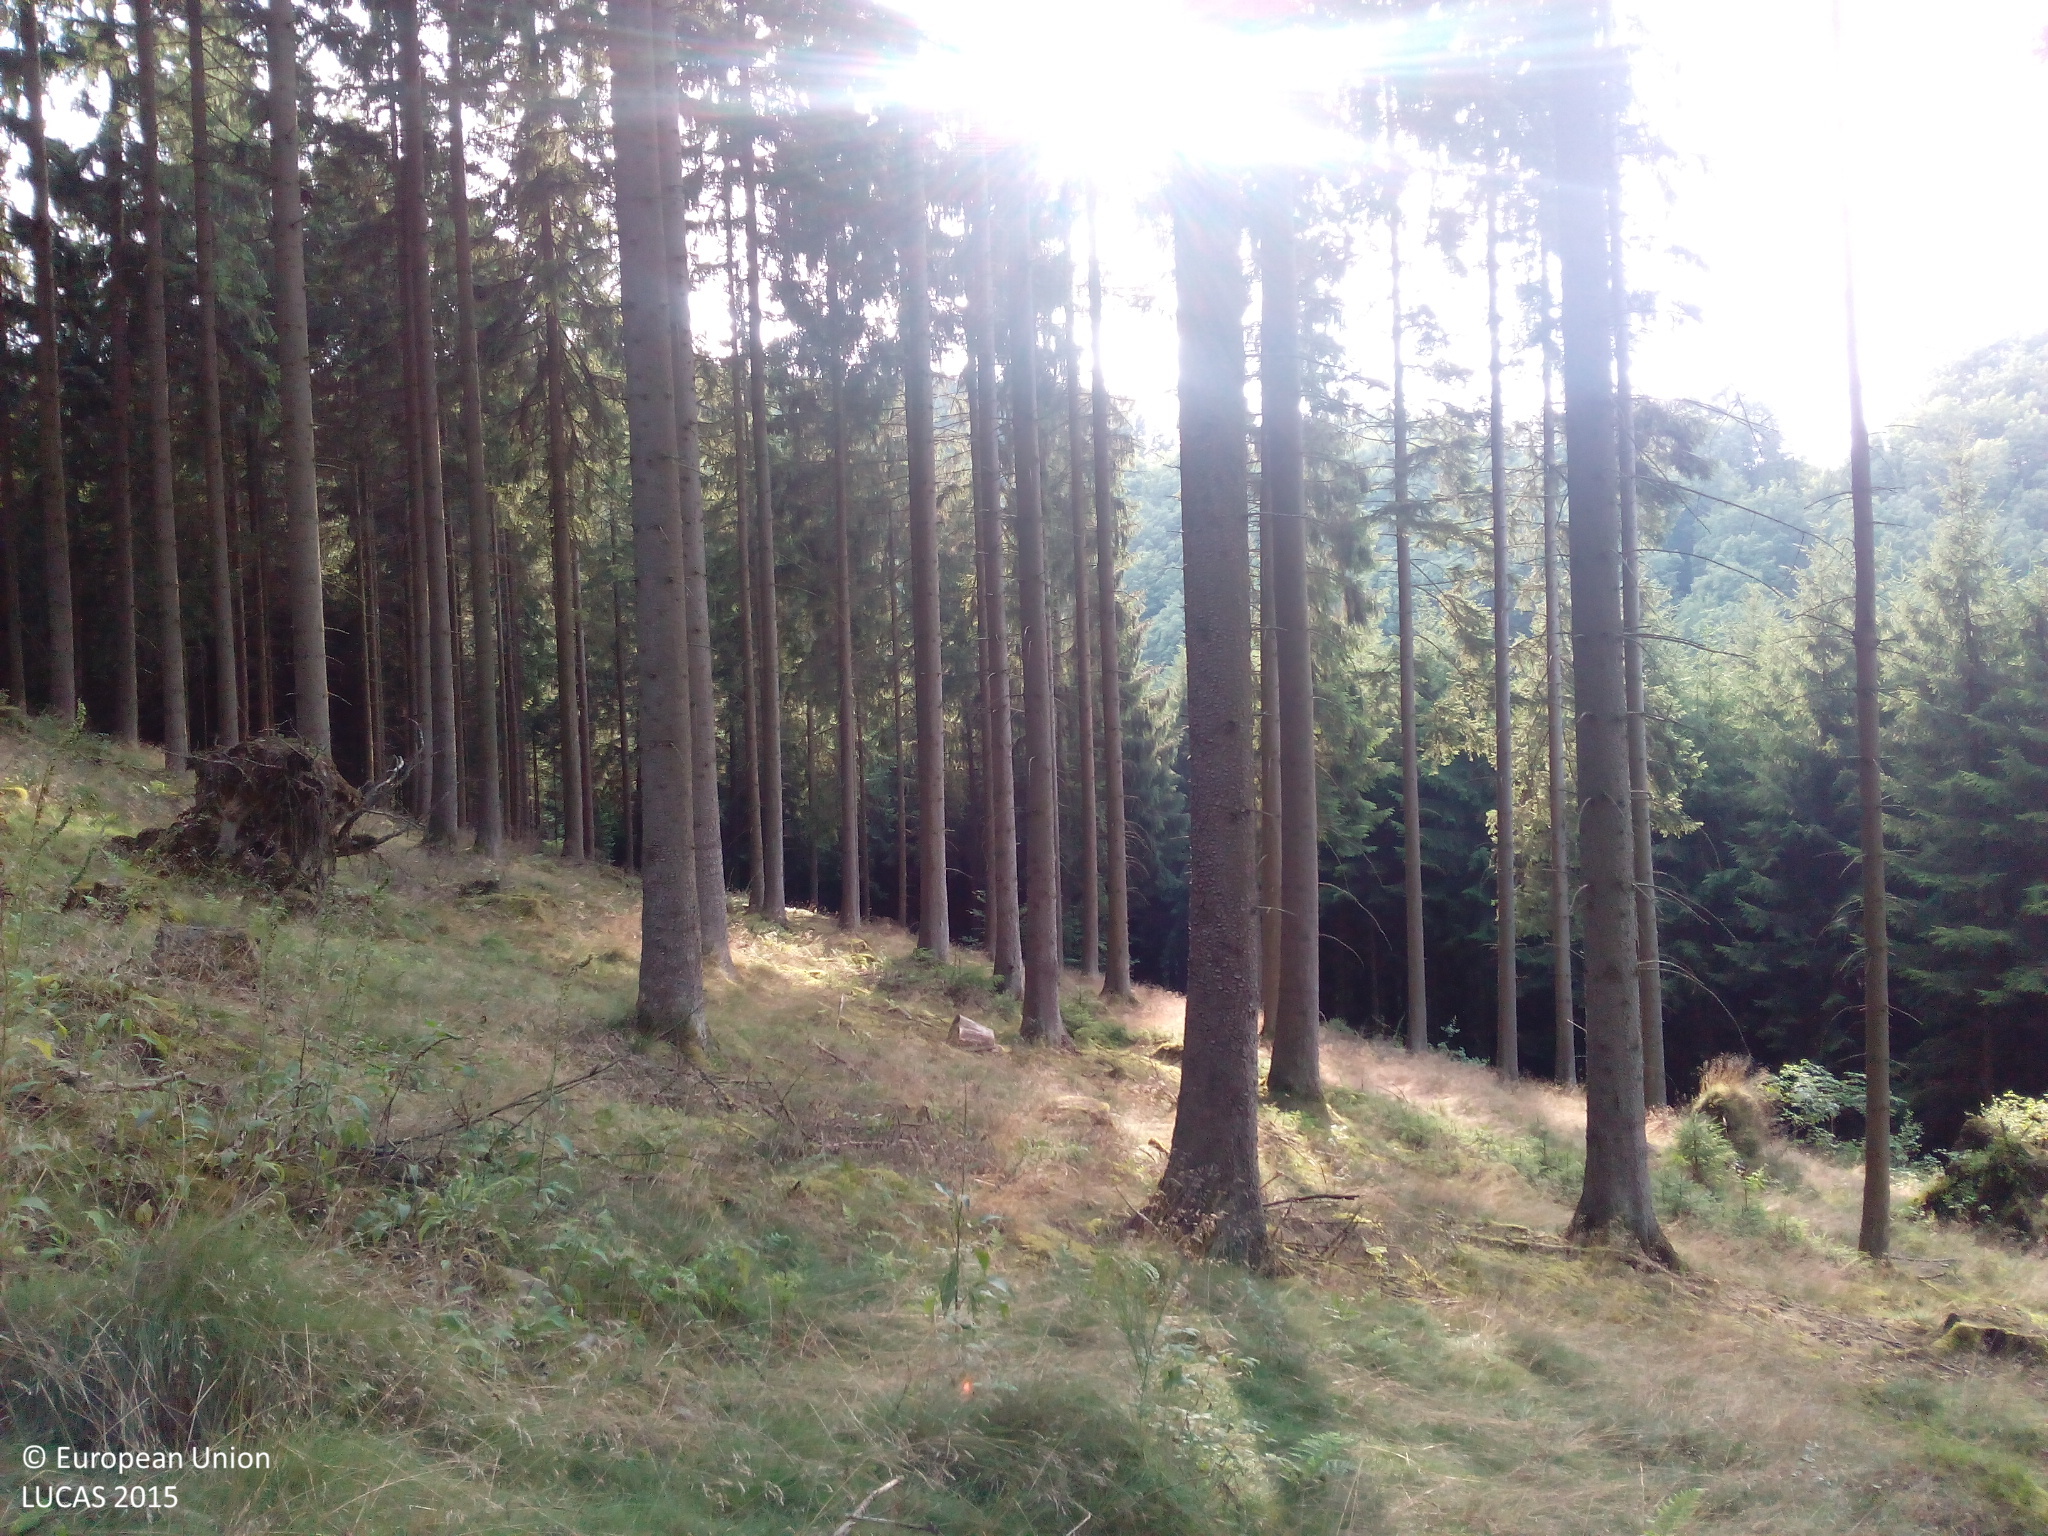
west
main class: Woodland
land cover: Spruce dominated coniferous woodland
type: hemiboreal forest and nemoral coniferous forest and mixed broadleaved-coniferous forest
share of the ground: > 75 %
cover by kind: coniferous forest trees 80 %, herbaceous plants 10 %, lichens and mosses 10 %
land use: Forestry
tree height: > 5 m
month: August
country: DE
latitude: 51.0838
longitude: 7.9875
